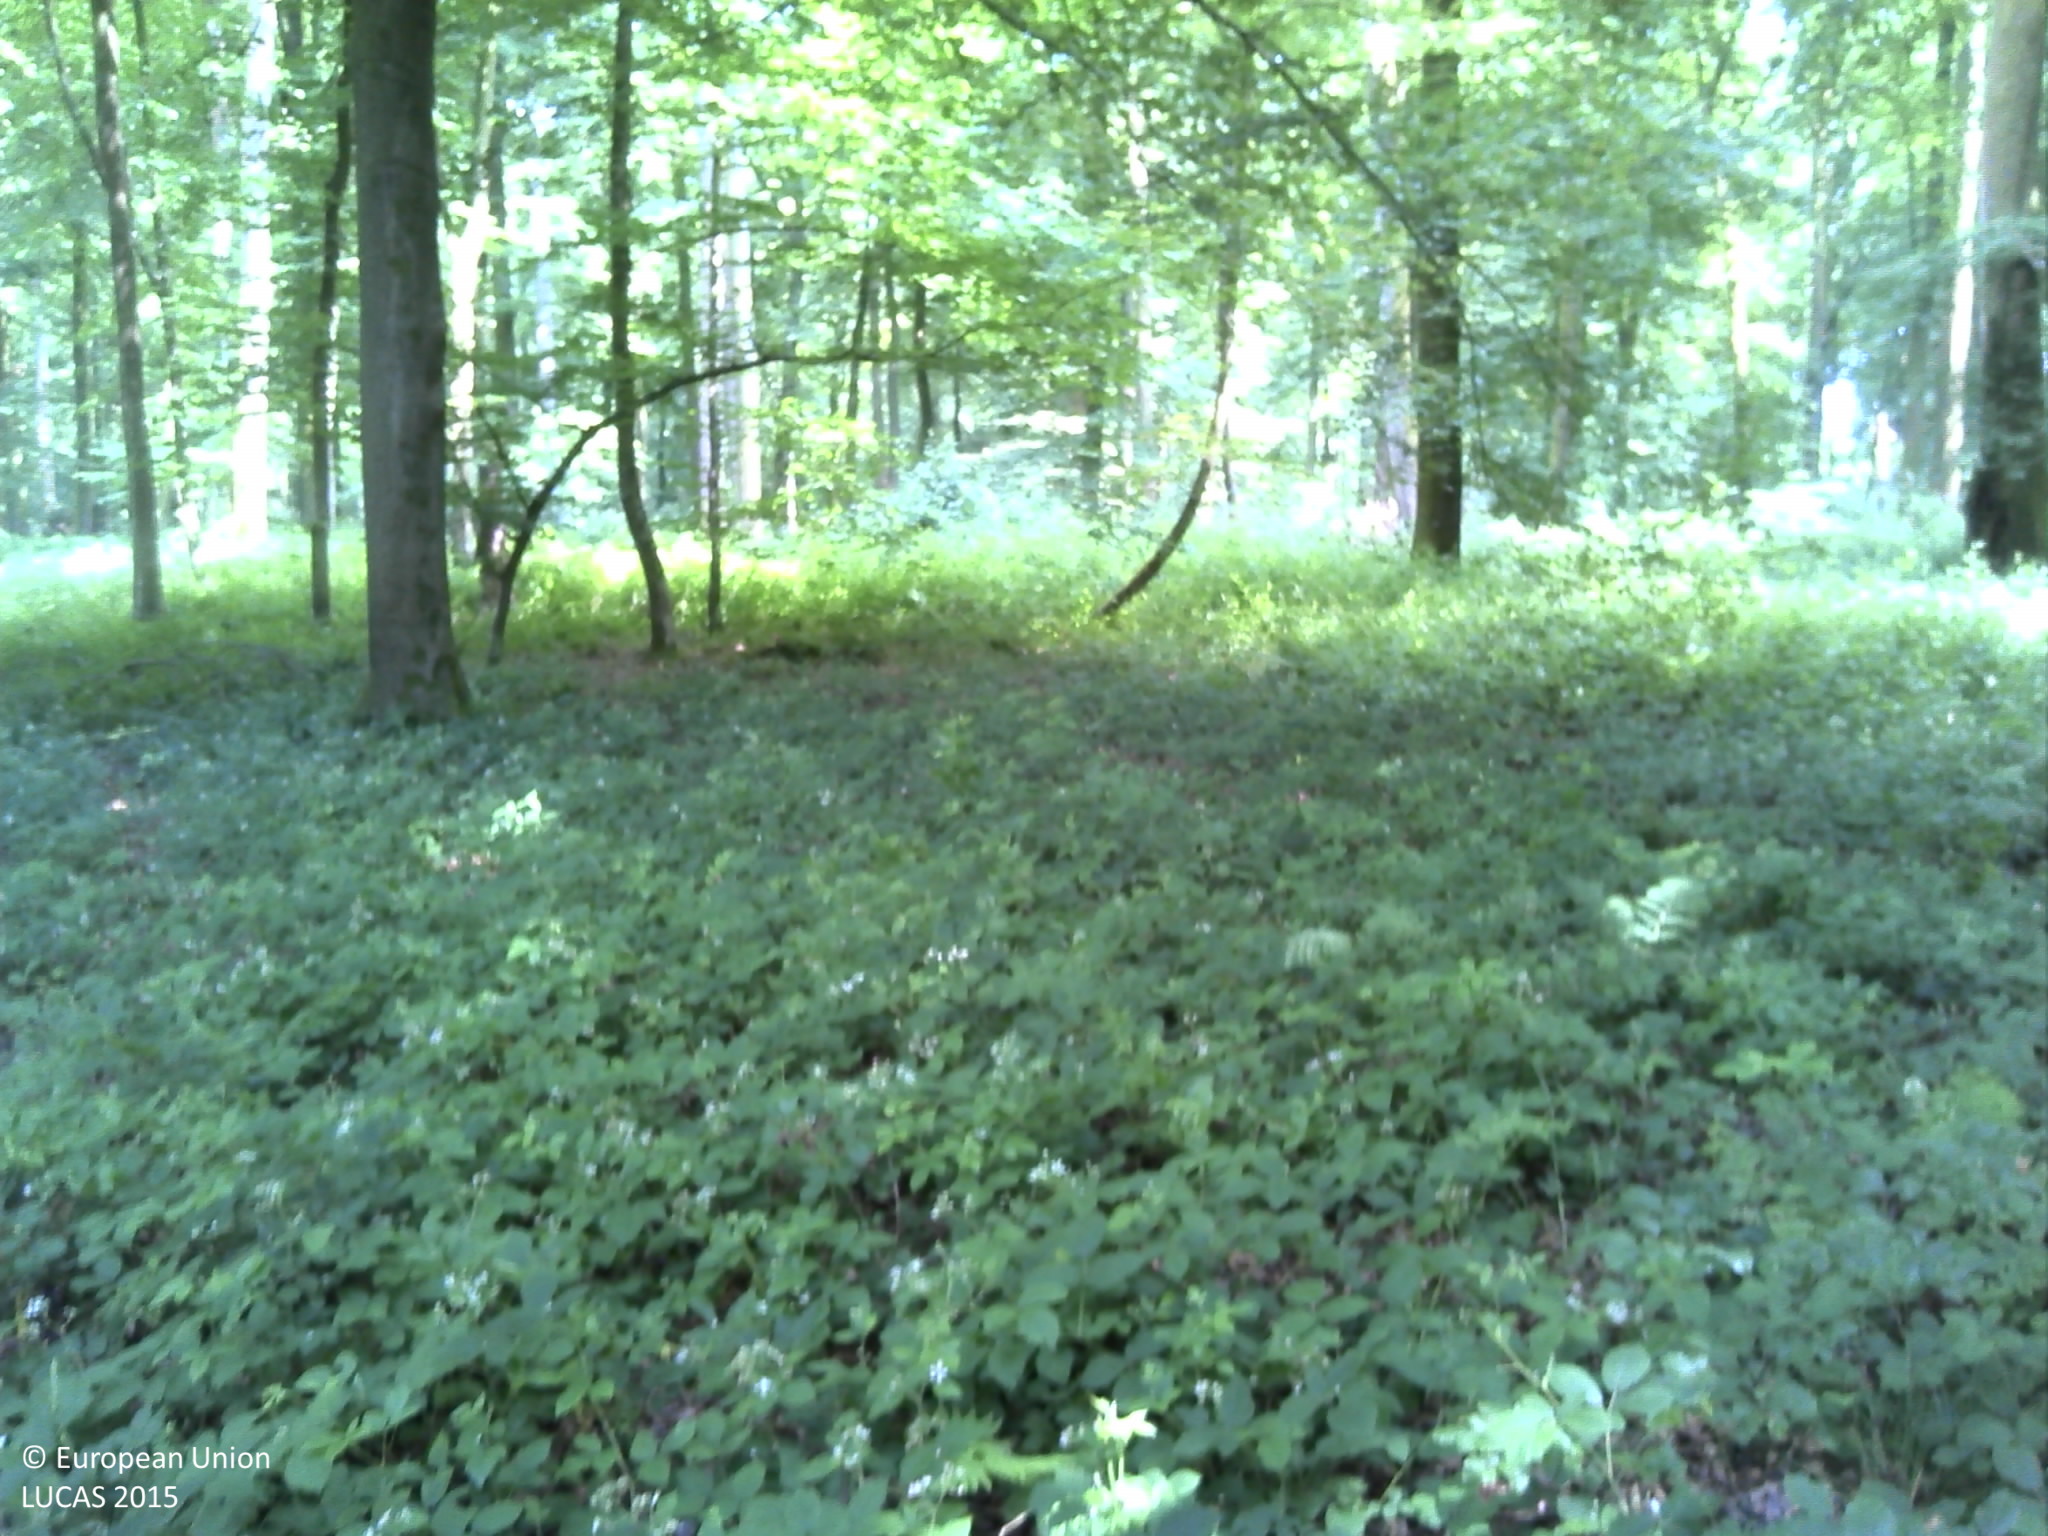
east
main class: Woodland
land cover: Broadleaved woodland
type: beech forest
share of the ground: > 75 %
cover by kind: broadleaved forest trees 100 %
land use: Forestry
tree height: > 5 m
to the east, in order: Broadleaved woodland
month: July
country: FR
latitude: 49.8931
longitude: 1.6160
